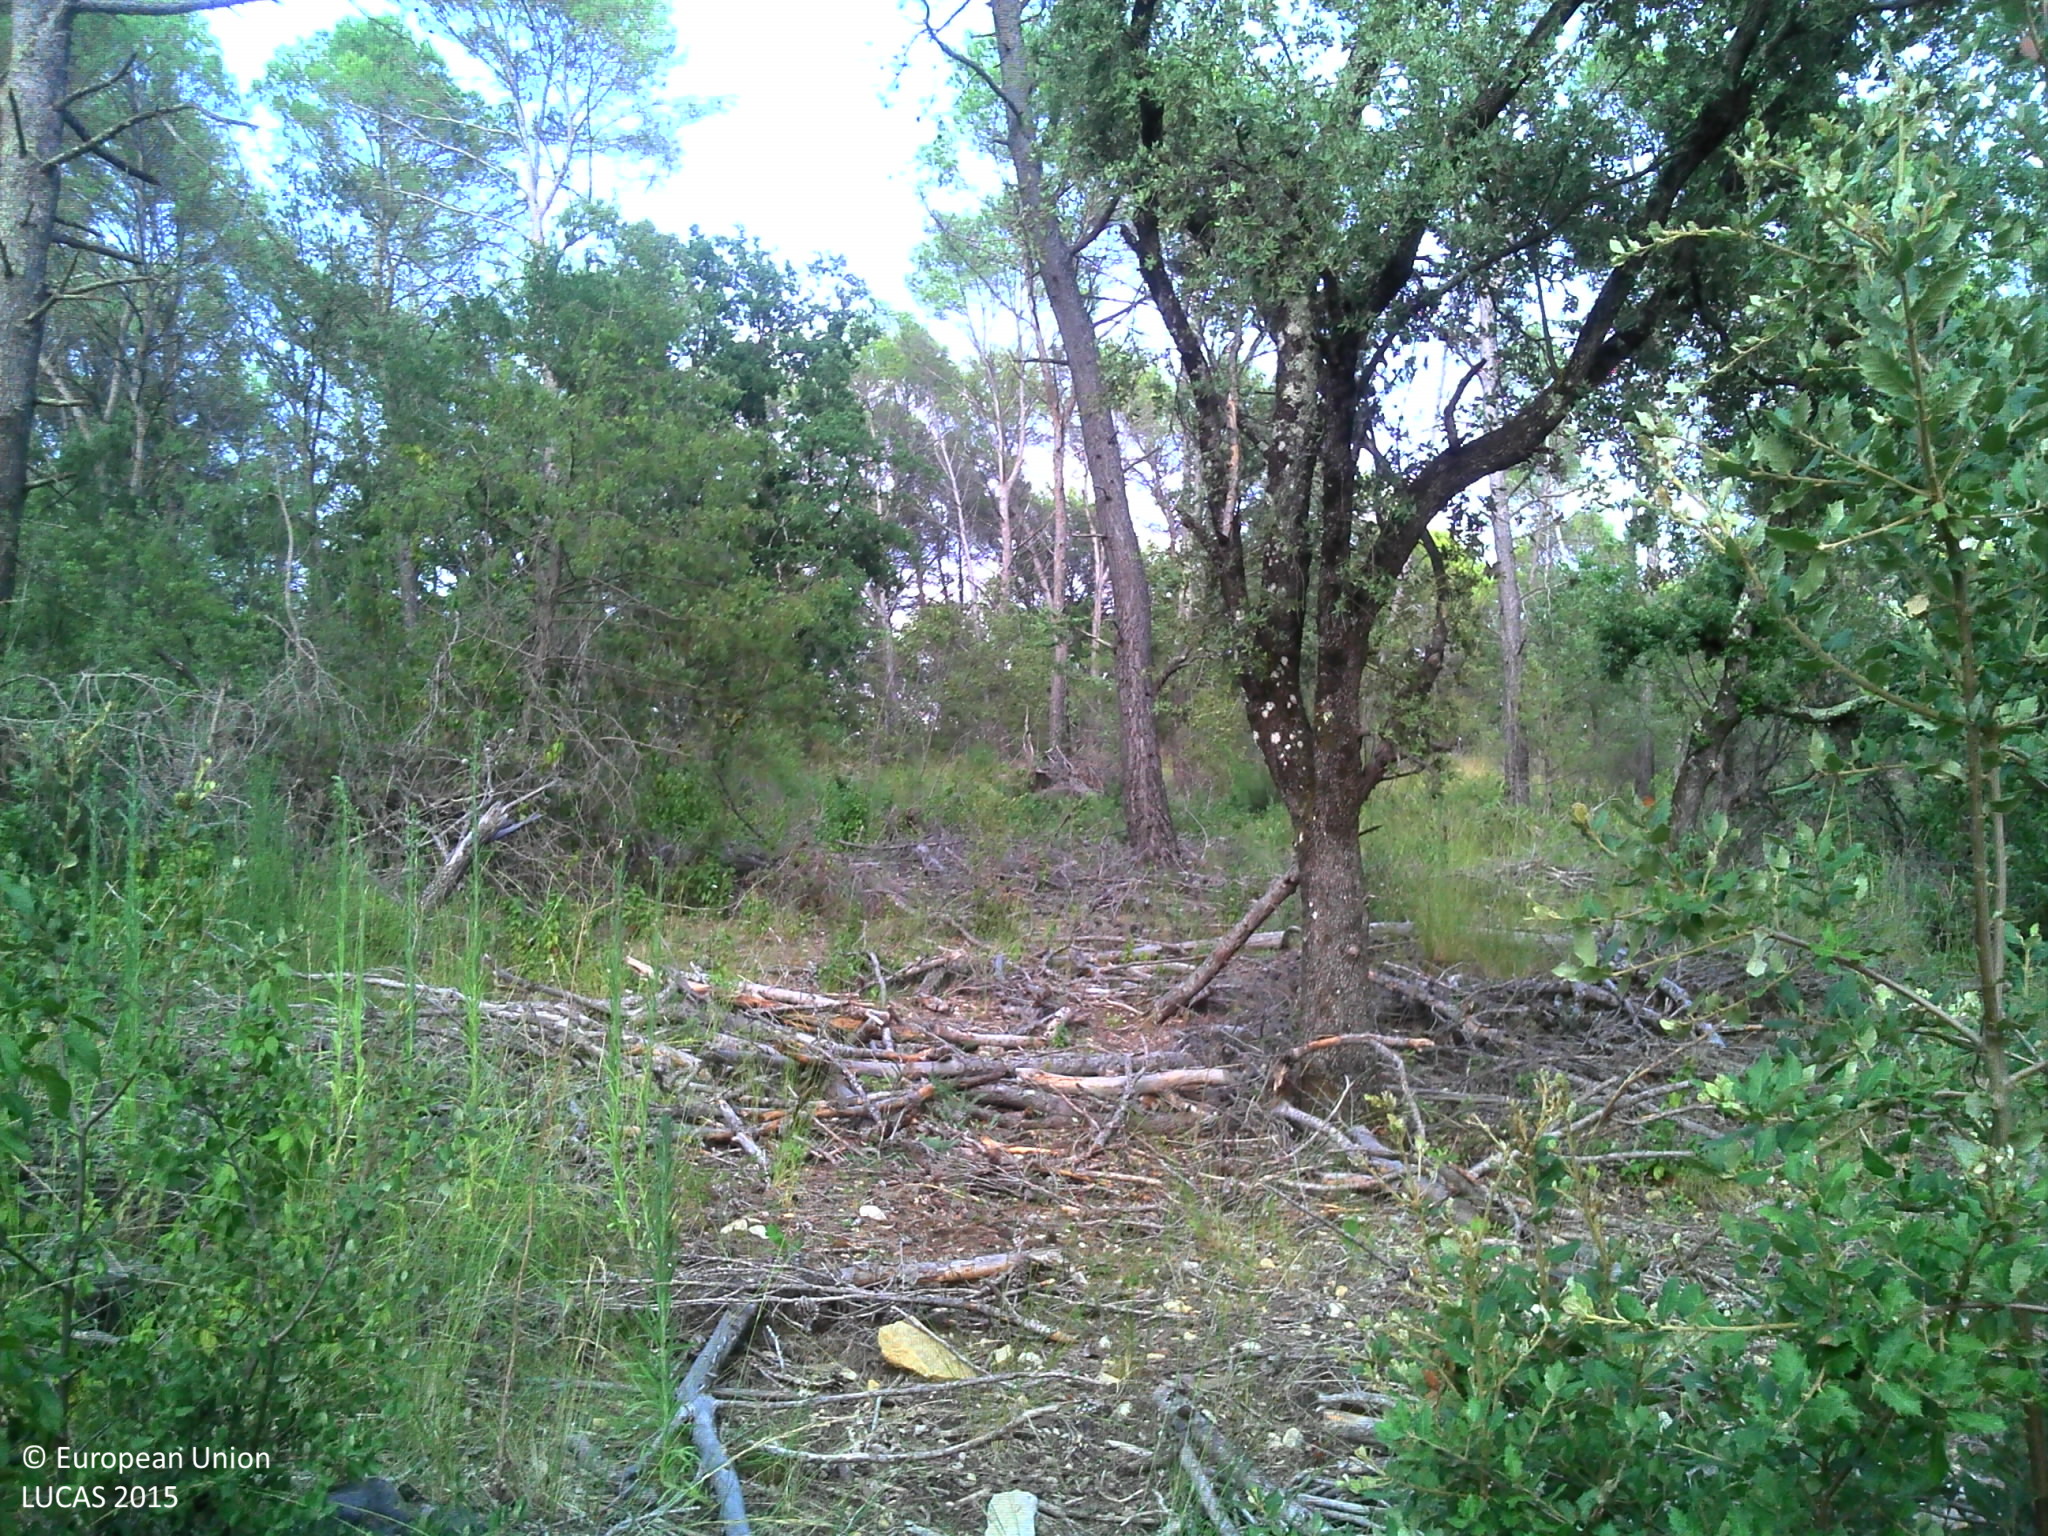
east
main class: Woodland
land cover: Pine dominated mixed woodland
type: coniferous forest of the mediterranean region
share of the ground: > 75 %
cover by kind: coniferous forest trees 50 %, broadleaved forest trees 25 %, shrubs 25 %
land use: Forestry
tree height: > 5 m
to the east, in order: Pine dominated mixed woodland; Tracks; Pine dominated mixed woodland
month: August
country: FR
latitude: 43.5256
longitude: 6.2846
